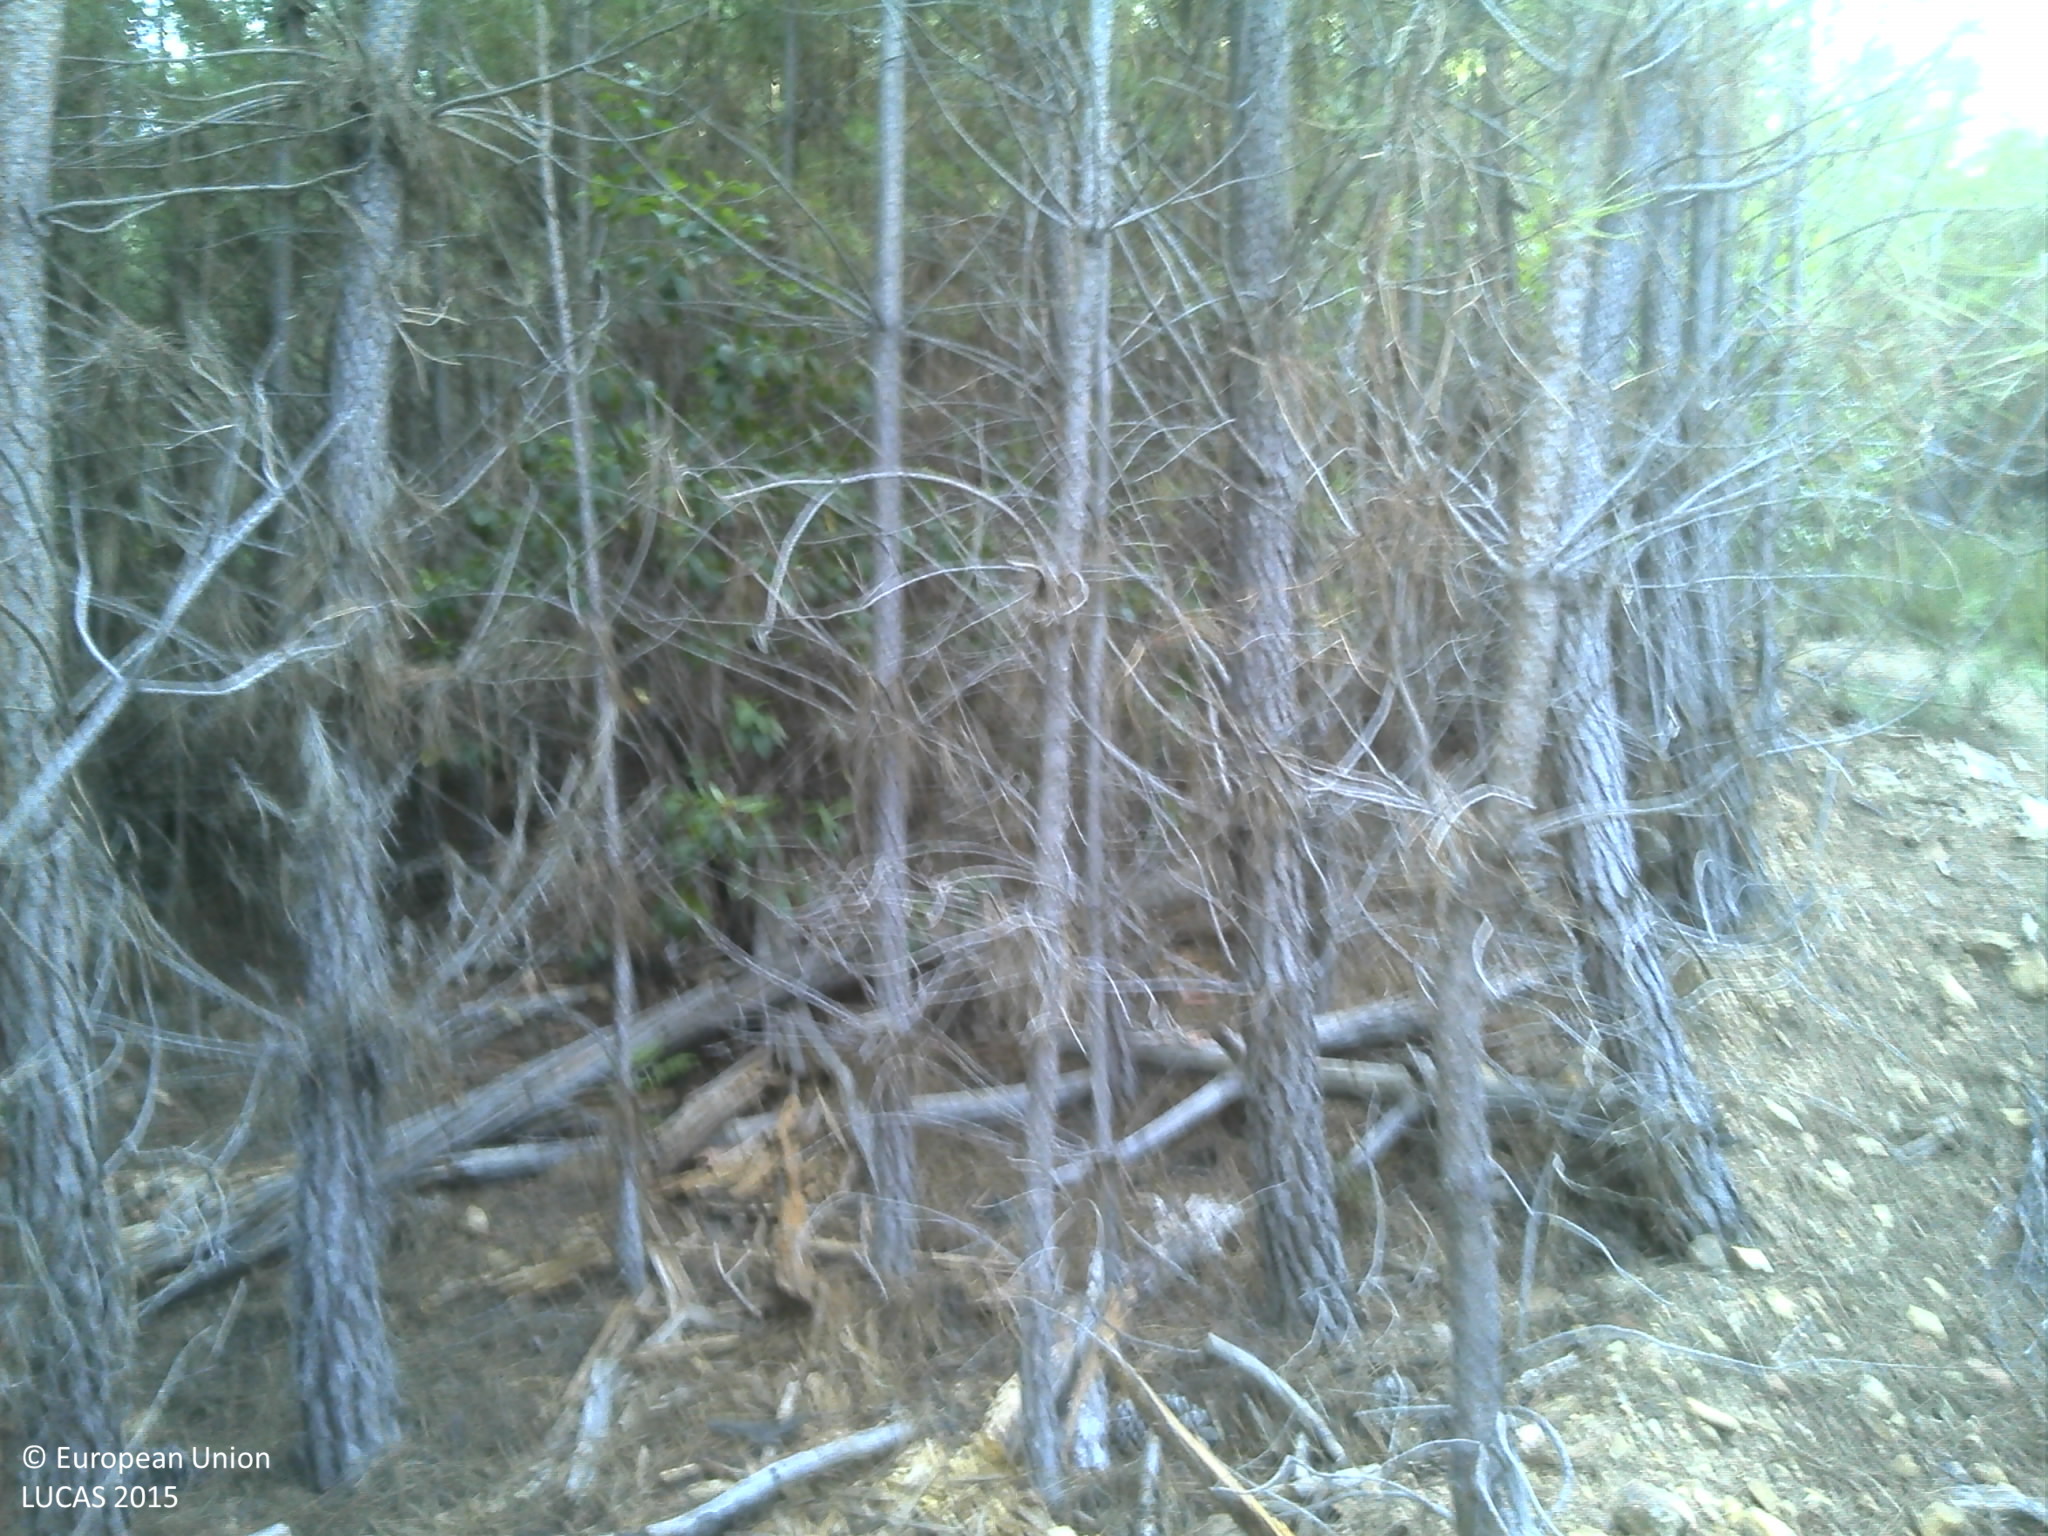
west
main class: Woodland
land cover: Pine dominated coniferous woodland
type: coniferous forest of the mediterranean region
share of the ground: 50 - 75 %
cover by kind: coniferous forest trees 65 %, shrubs 25 %, unconsolidated bare surface 5 %
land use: Forestry
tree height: > 5 m
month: July
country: PT
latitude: 39.9203
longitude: -7.7863
